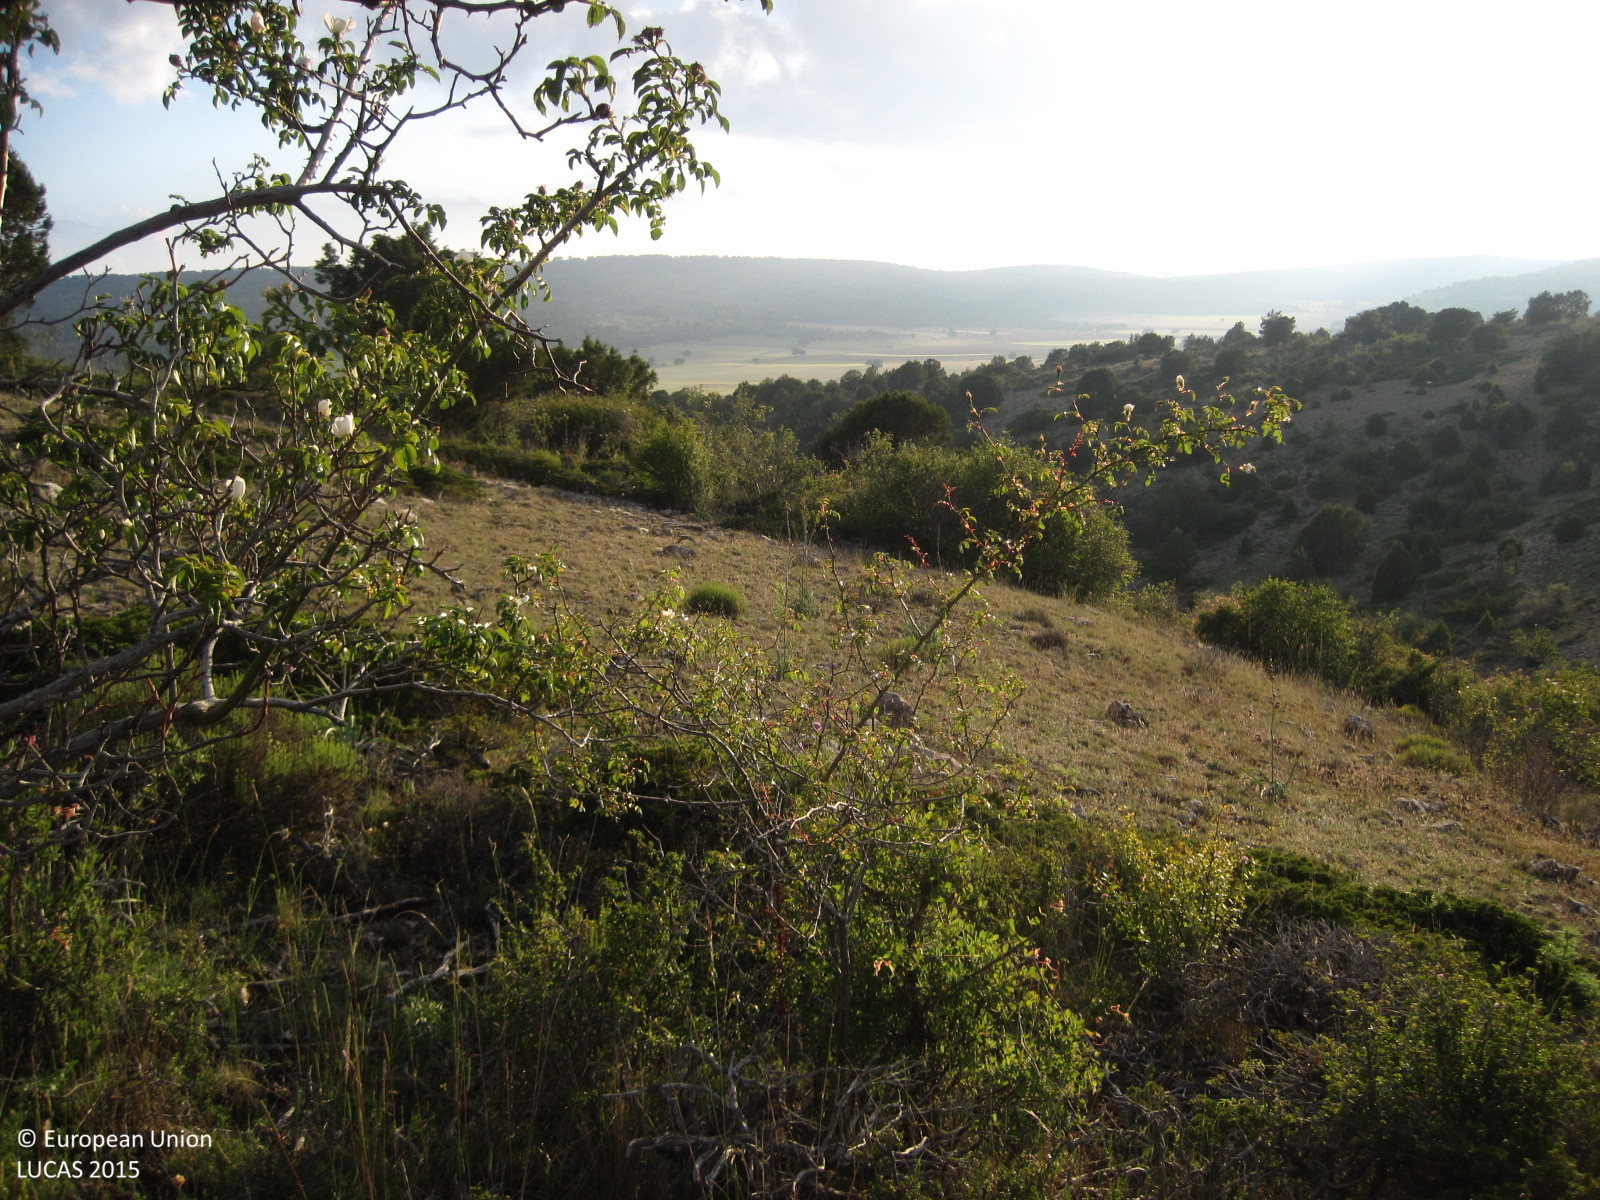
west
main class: Shrubland
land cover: Shrubland with sparse tree cover
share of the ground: 10 - 25 %
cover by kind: herbaceous plants 50 %, consolidated bare surface 25 %, shrubs 20 %, coniferous forest trees 5 %
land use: Semi-natural and natural areas not in use
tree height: < 5 m
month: June
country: ES
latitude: 39.9830
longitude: -0.9314
